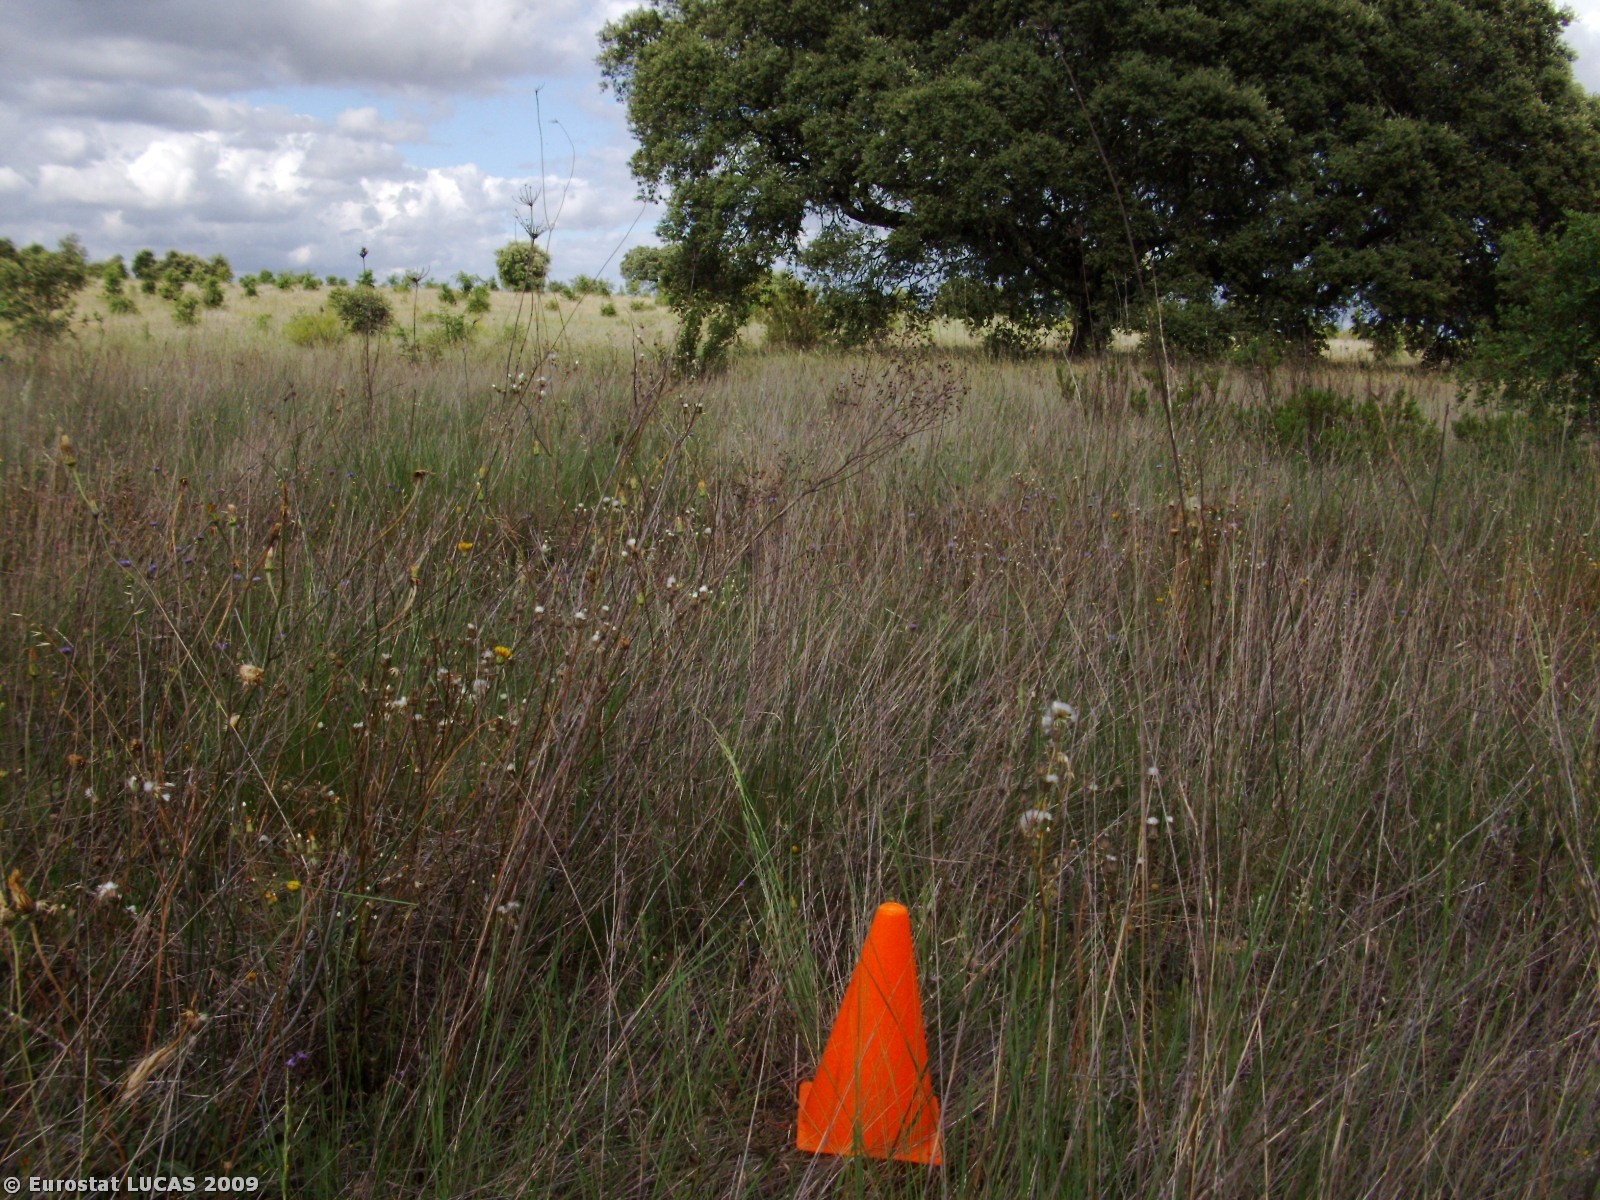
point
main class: Woodland
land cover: Broadleaved woodland
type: broadleaved evergreen forest
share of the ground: 10 - 25 %
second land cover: Spontaneously vegetated surfaces
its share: 50 - 75 %
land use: Forestry
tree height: > 5 m
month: May
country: PT
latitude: 39.2286
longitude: -7.8315
